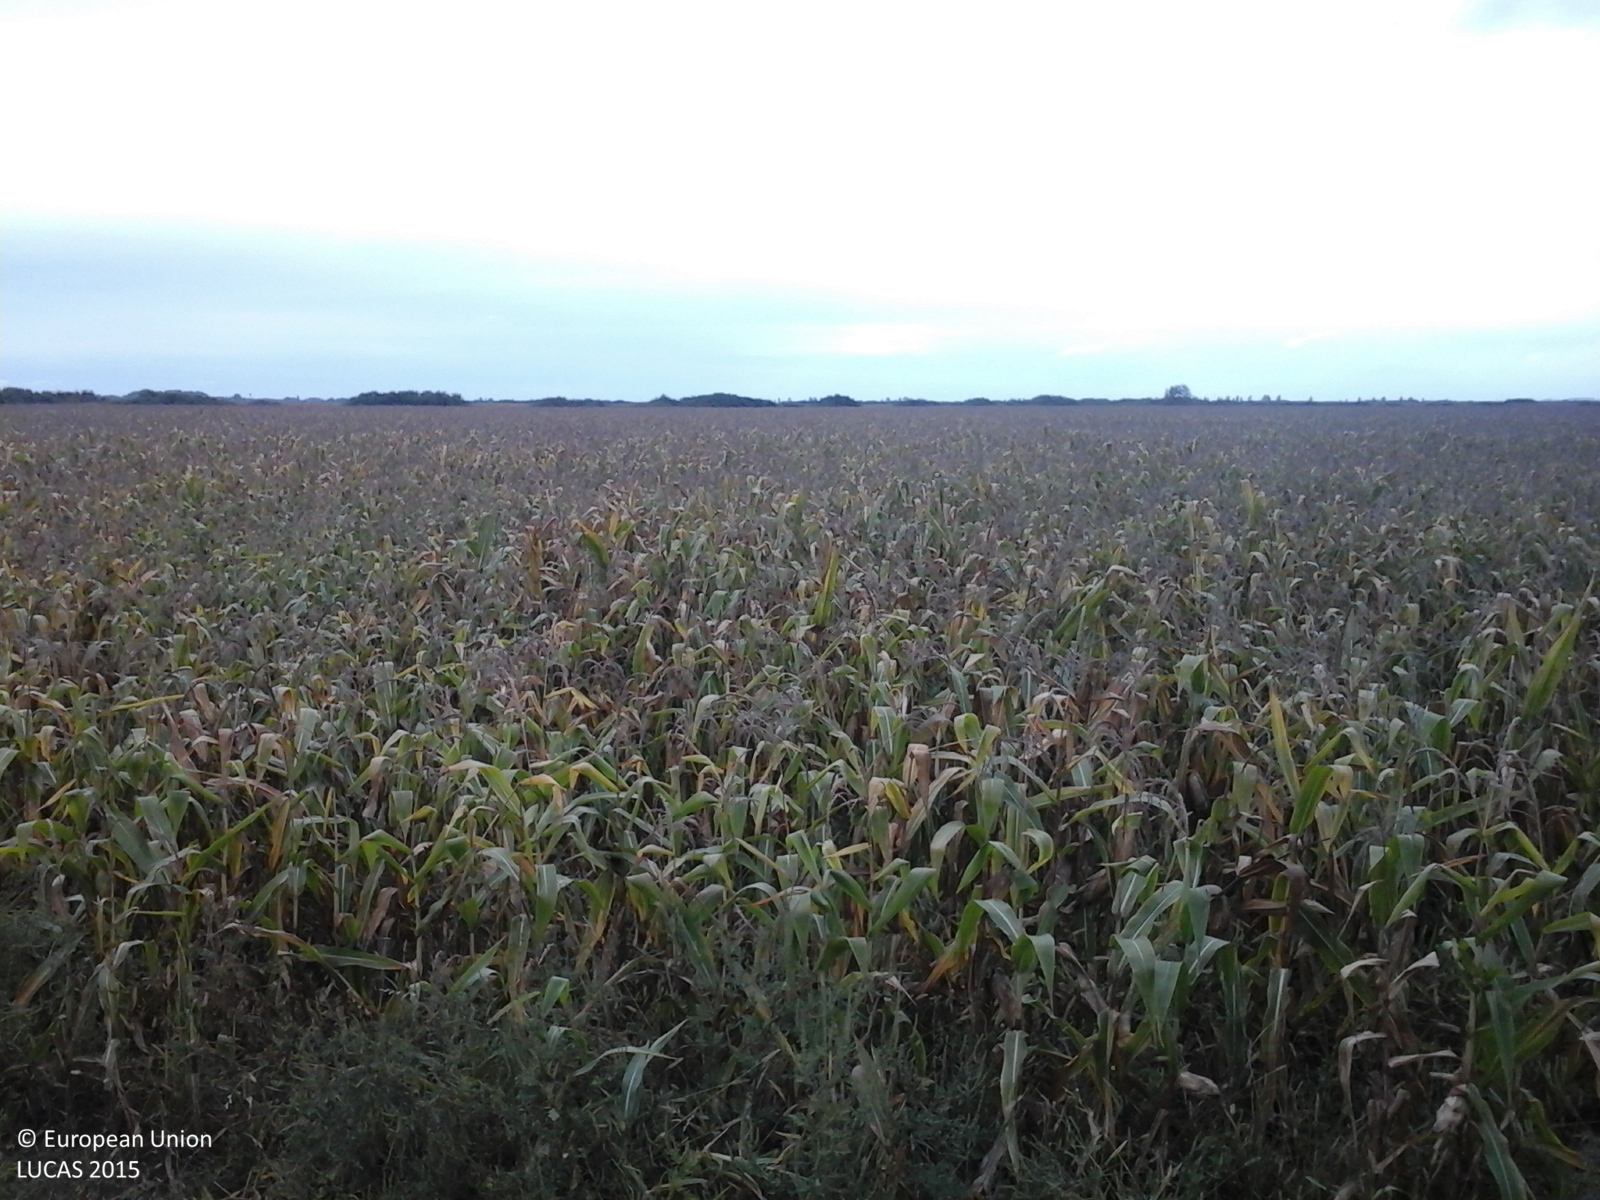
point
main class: Cropland
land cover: Maize
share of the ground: > 75 %
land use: Agriculture (excluding fallow land and kitchen gardens)
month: September
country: RO
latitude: 46.7552
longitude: 21.7594
